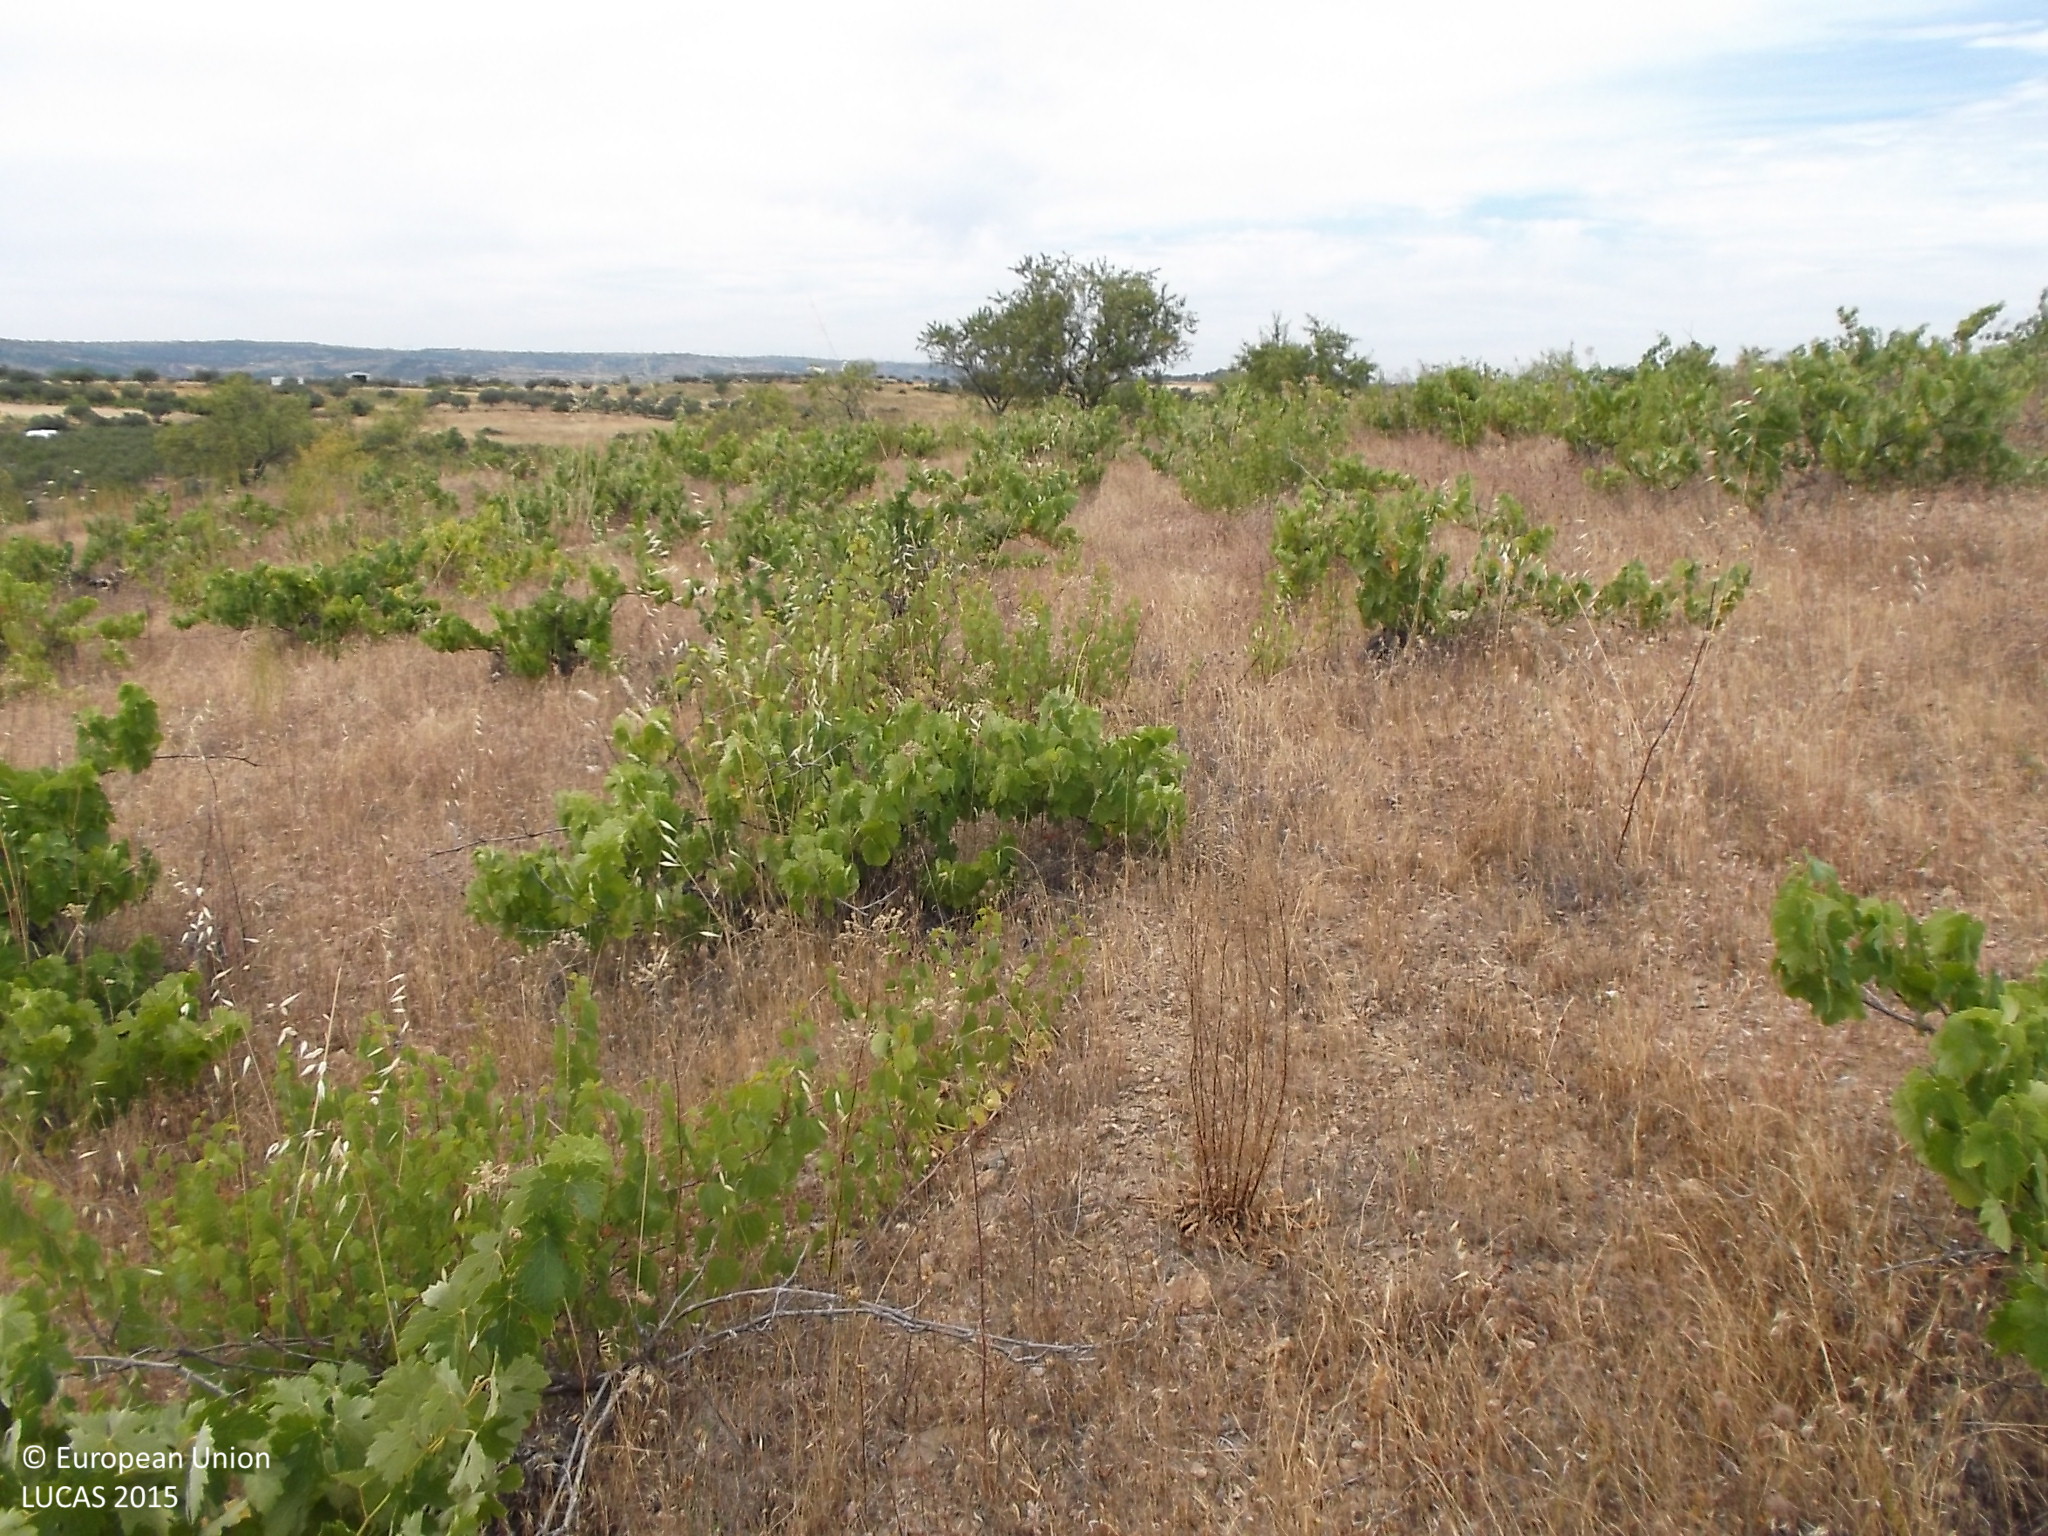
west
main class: Cropland
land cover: Vineyards
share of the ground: 10 - 25 %
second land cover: Spontaneously vegetated surfaces
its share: > 75 %
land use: Agriculture (excluding fallow land and kitchen gardens)
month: July
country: ES
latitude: 41.3064
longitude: -6.4012
